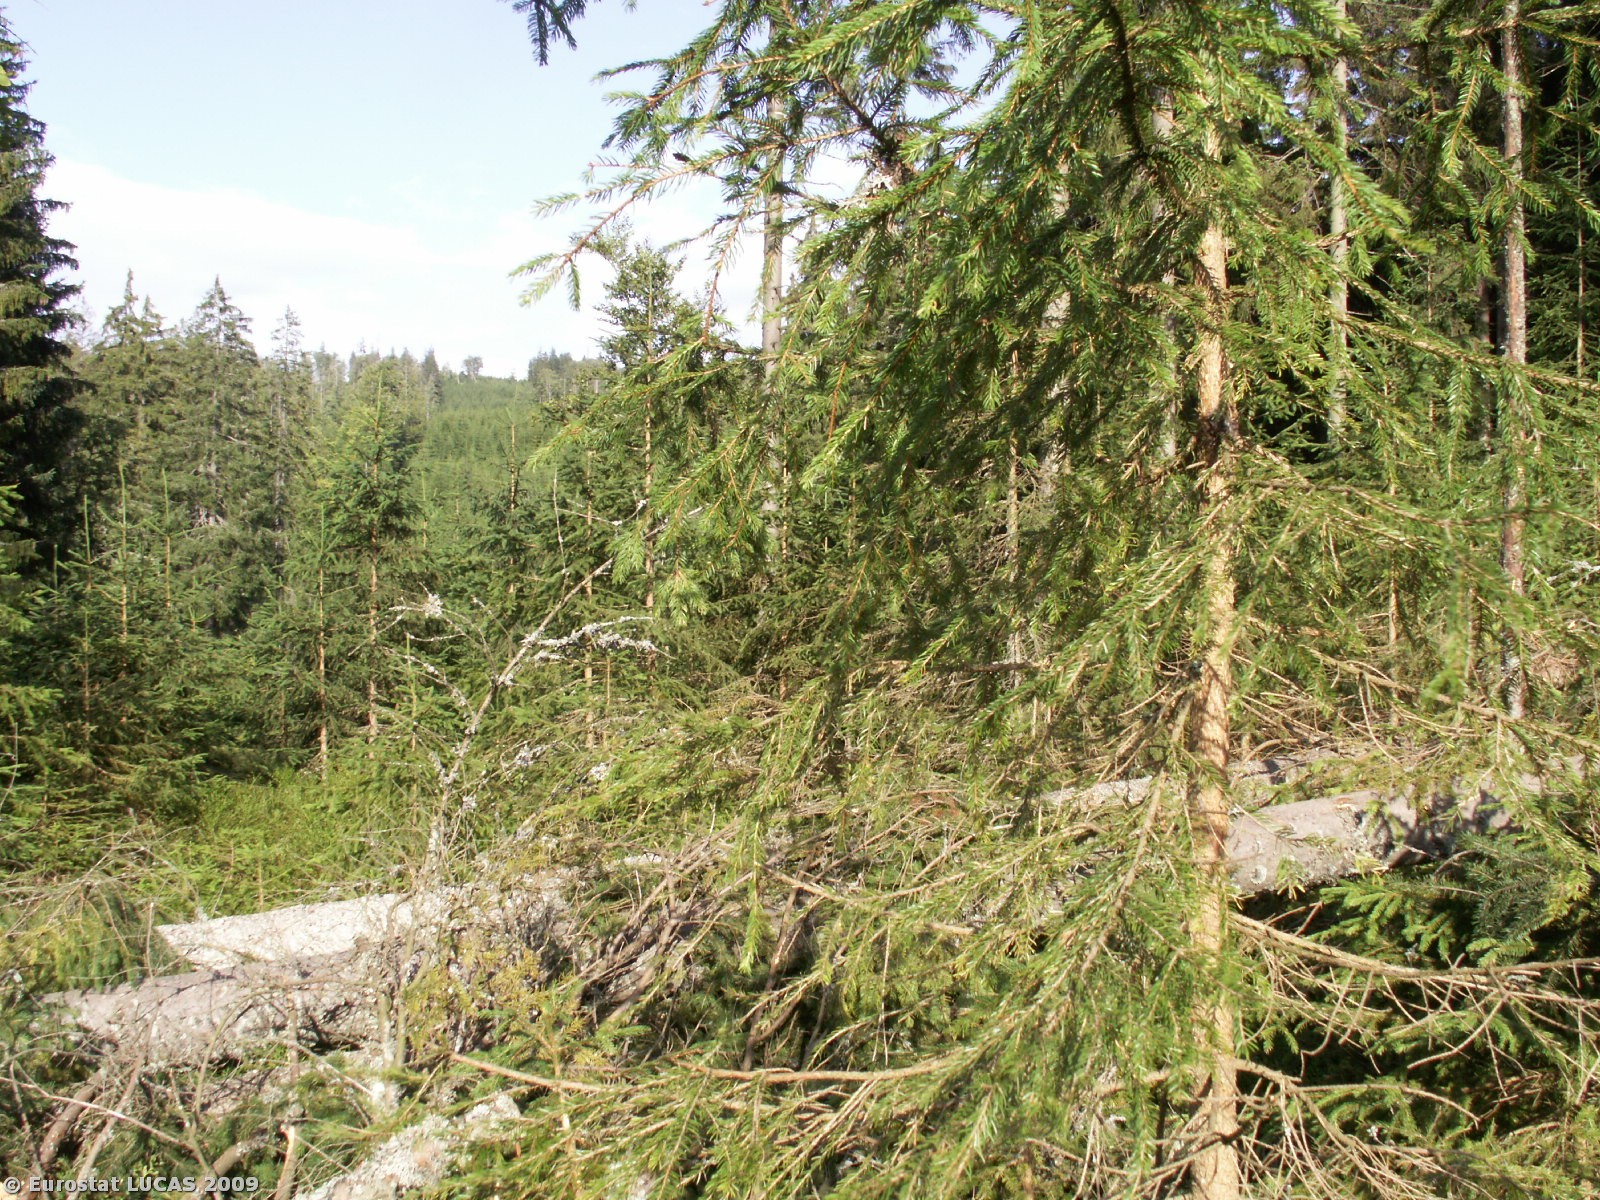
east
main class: Woodland
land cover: Coniferous woodland
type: hemiboreal forest and nemoral coniferous forest and mixed broadleaved-coniferous forest
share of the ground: > 75 %
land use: Forestry
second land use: Nature reserves
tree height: > 5 m
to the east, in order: Coniferous woodland; Tracks; Coniferous woodland; Inland running water; Coniferous woodland; Tracks; Coniferous woodland; Rivers and streams; Coniferous woodland
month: July
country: CZ
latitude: 48.8056
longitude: 13.8261
